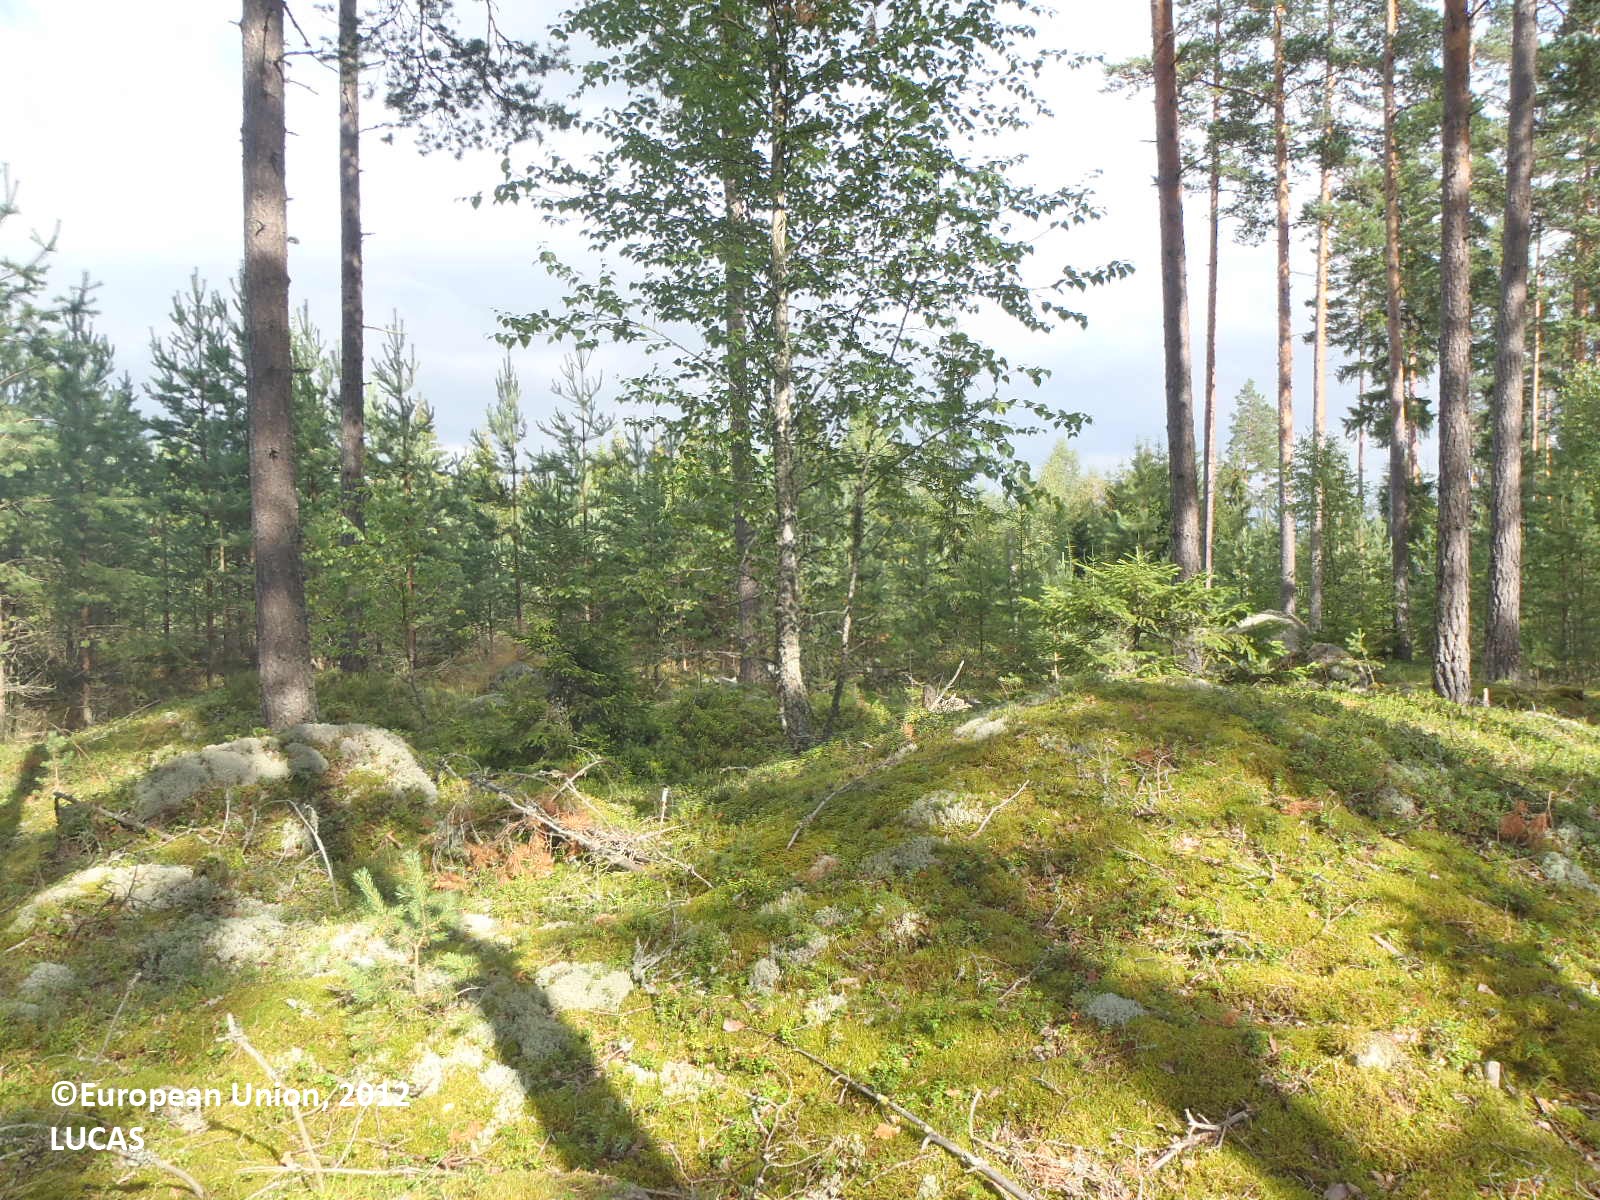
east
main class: Woodland
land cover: Pine dominated coniferous woodland
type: boreal forest
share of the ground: 50 - 75 %
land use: Forestry
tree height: > 5 m
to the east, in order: Pine dominated coniferous woodland; Shrubland with sparse tree cover; Pine dominated mixed woodland
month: July
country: FI
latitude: 60.8166
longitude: 21.7694
